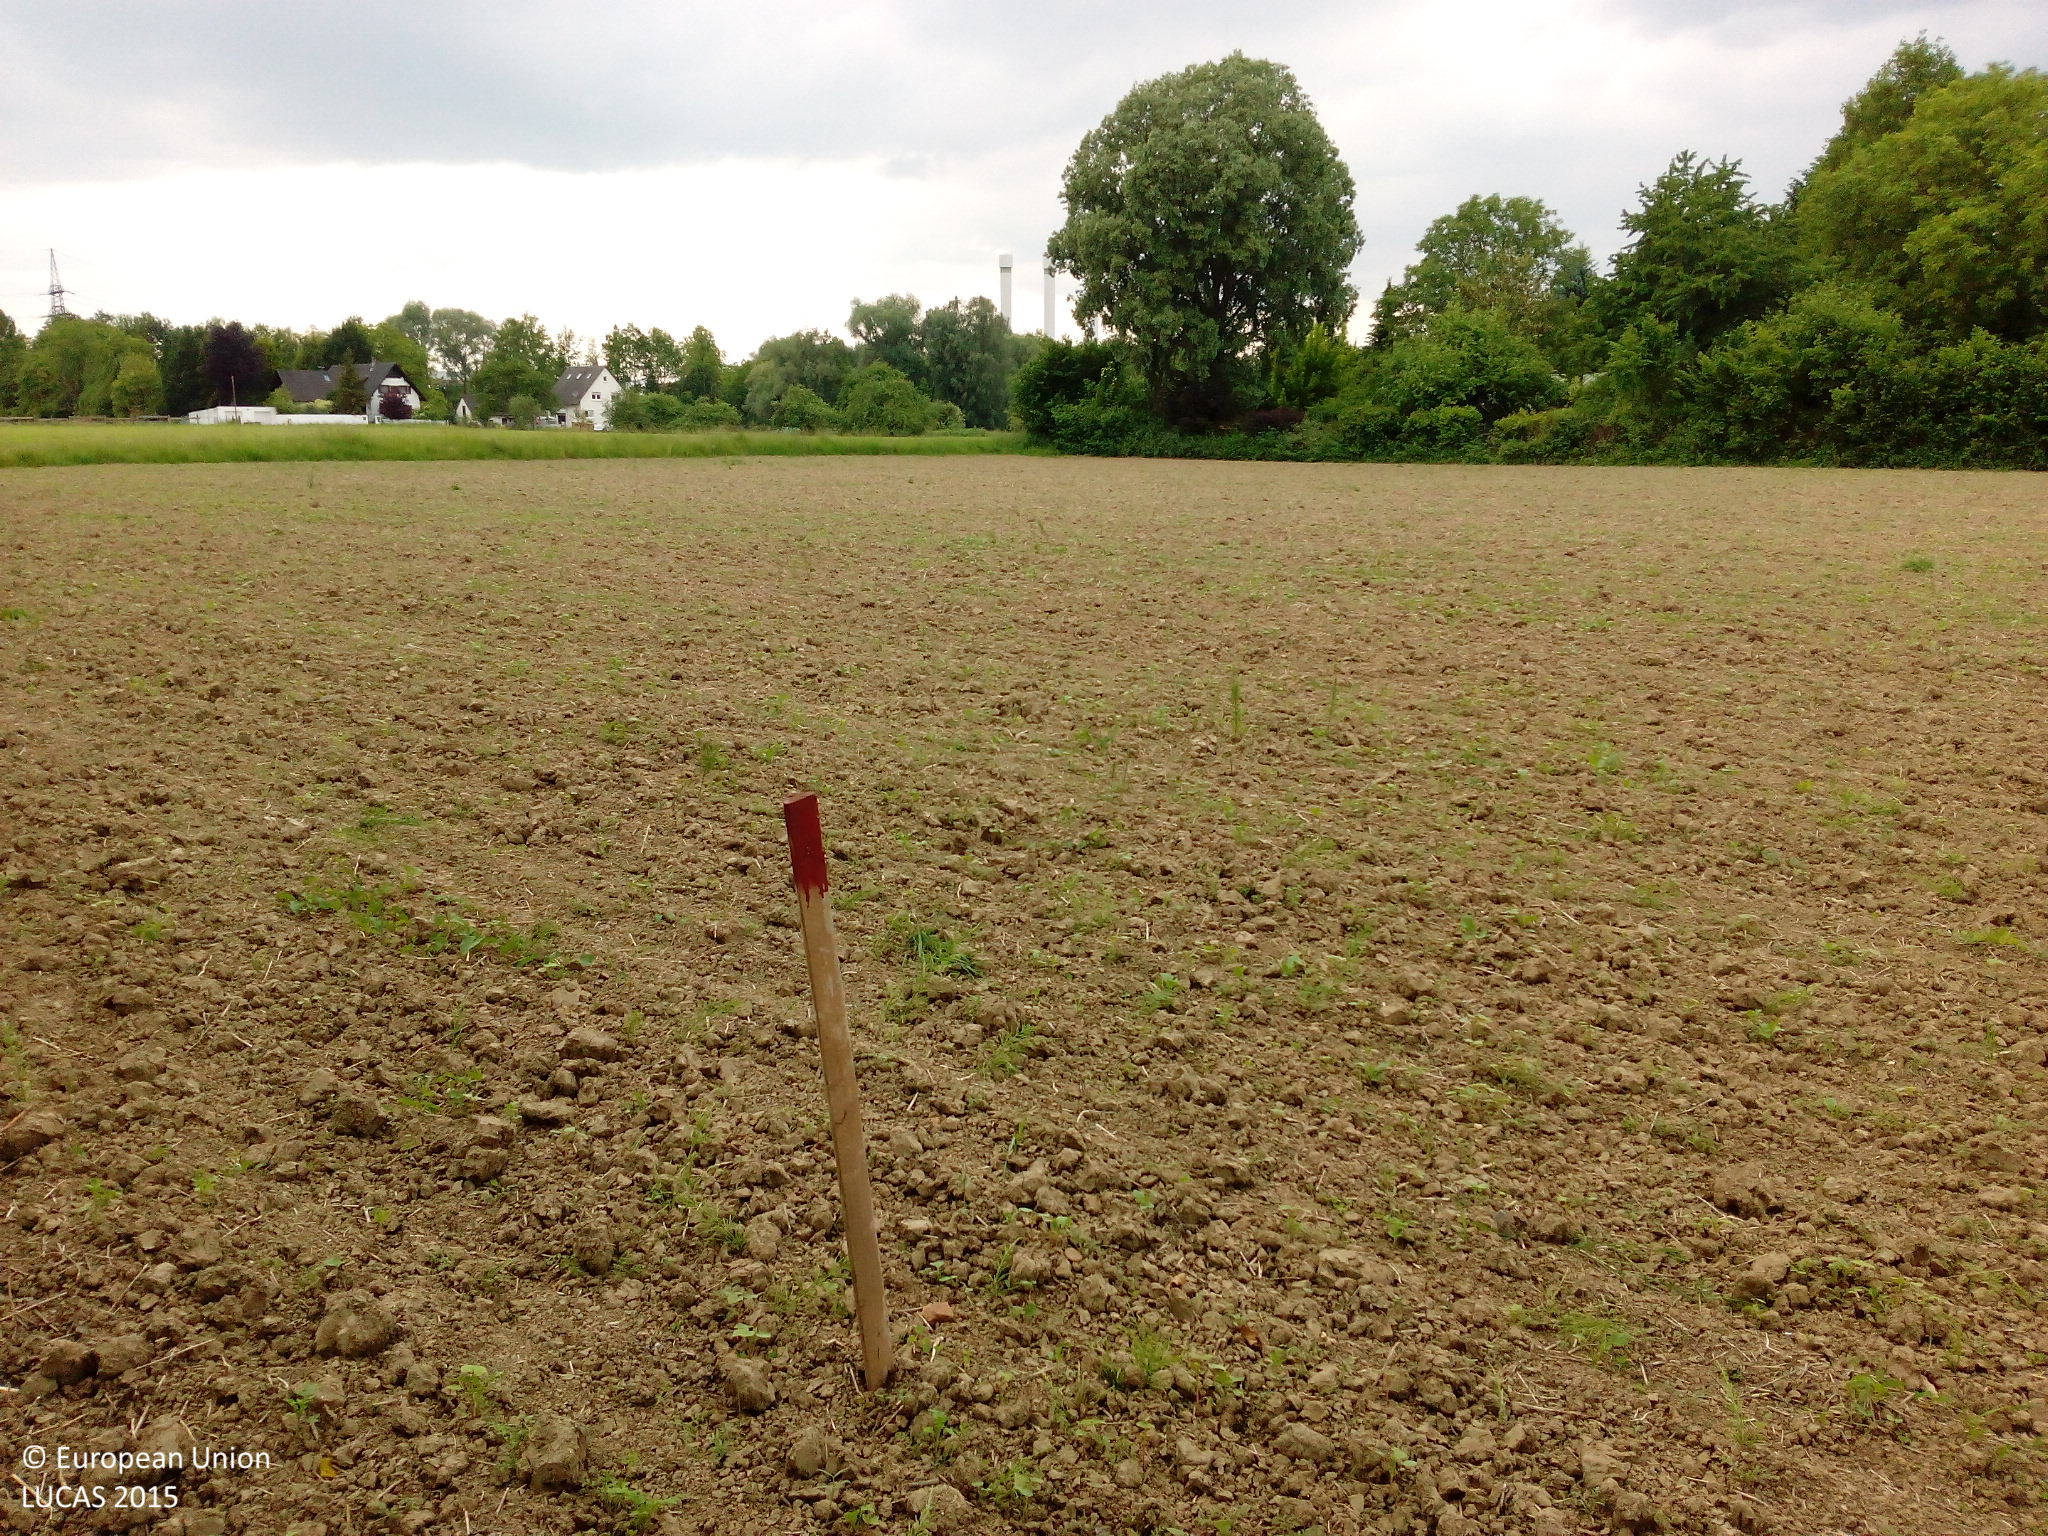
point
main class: Cropland
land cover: Other cereals
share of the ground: 10 - 25 %
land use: Agriculture (excluding fallow land and kitchen gardens)
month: May
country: DE
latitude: 48.8565
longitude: 8.1879
